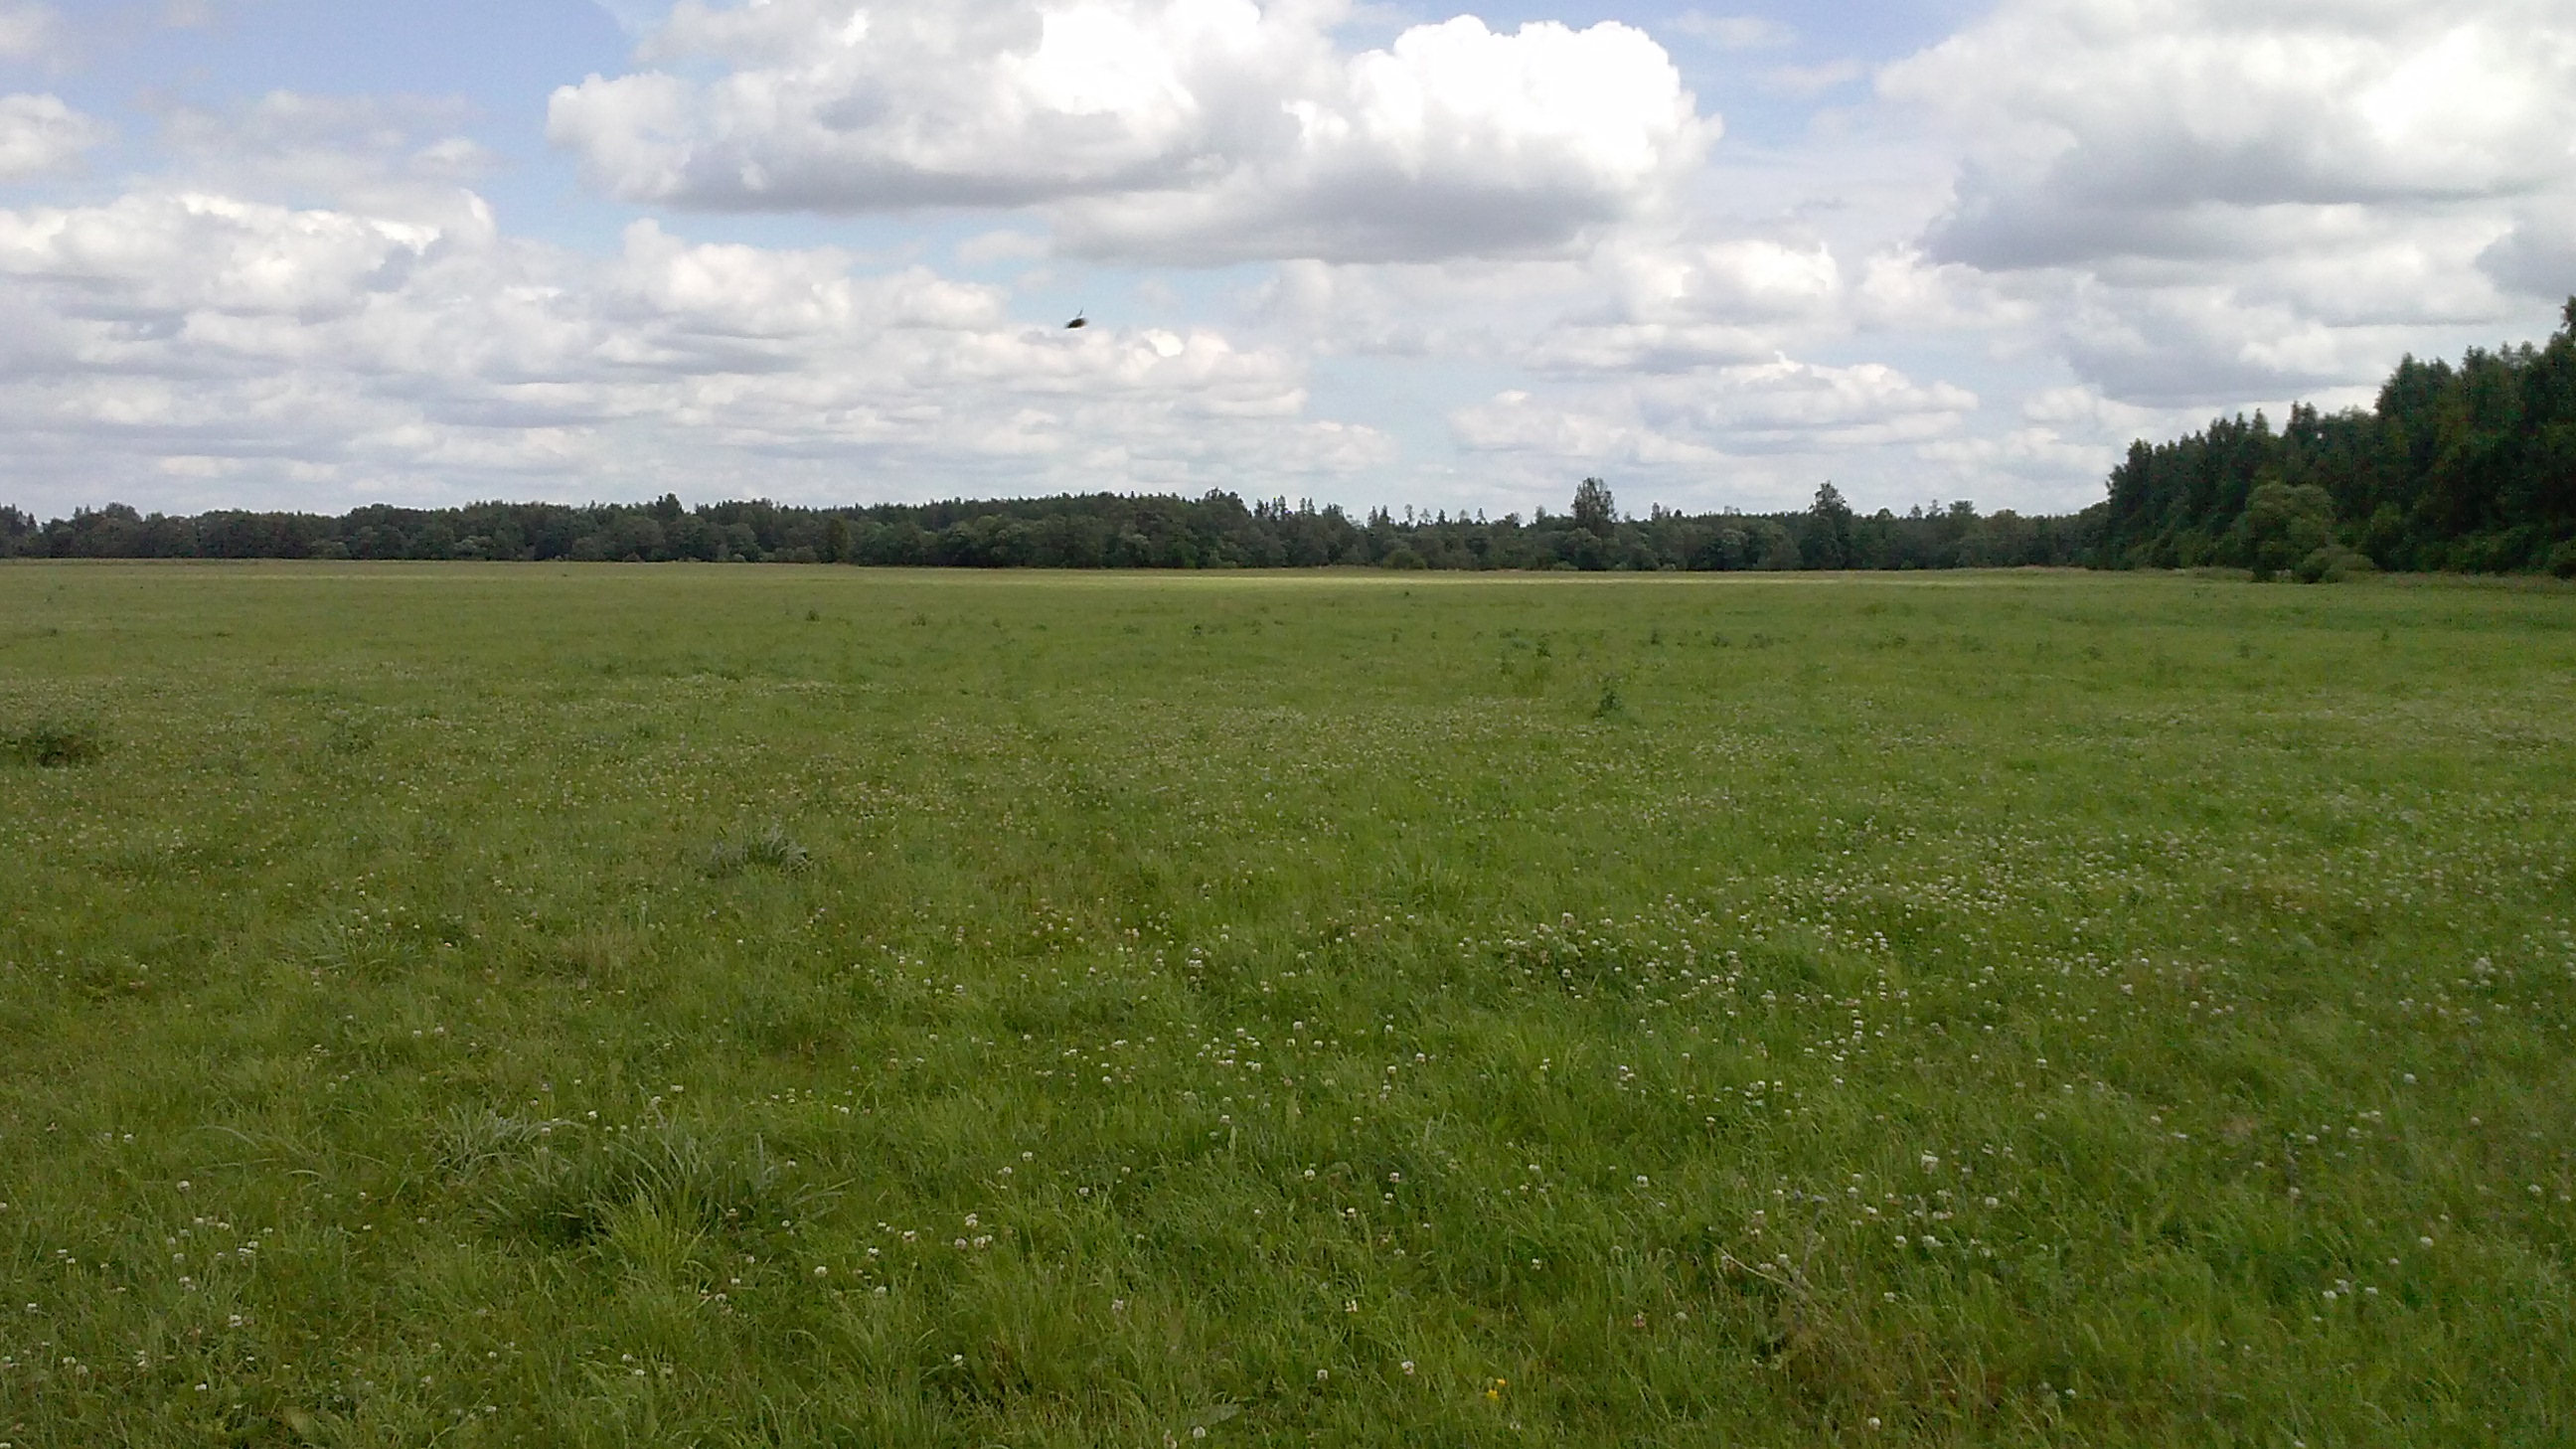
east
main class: Grassland
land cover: Grassland without tree/shrub cover
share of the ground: > 75 %
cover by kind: herbaceous plants 100 %
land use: Agriculture (excluding fallow land and kitchen gardens)
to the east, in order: Grassland without tree/shrub cover; Shruby margins
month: July
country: LV
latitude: 56.5214
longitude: 26.9524
